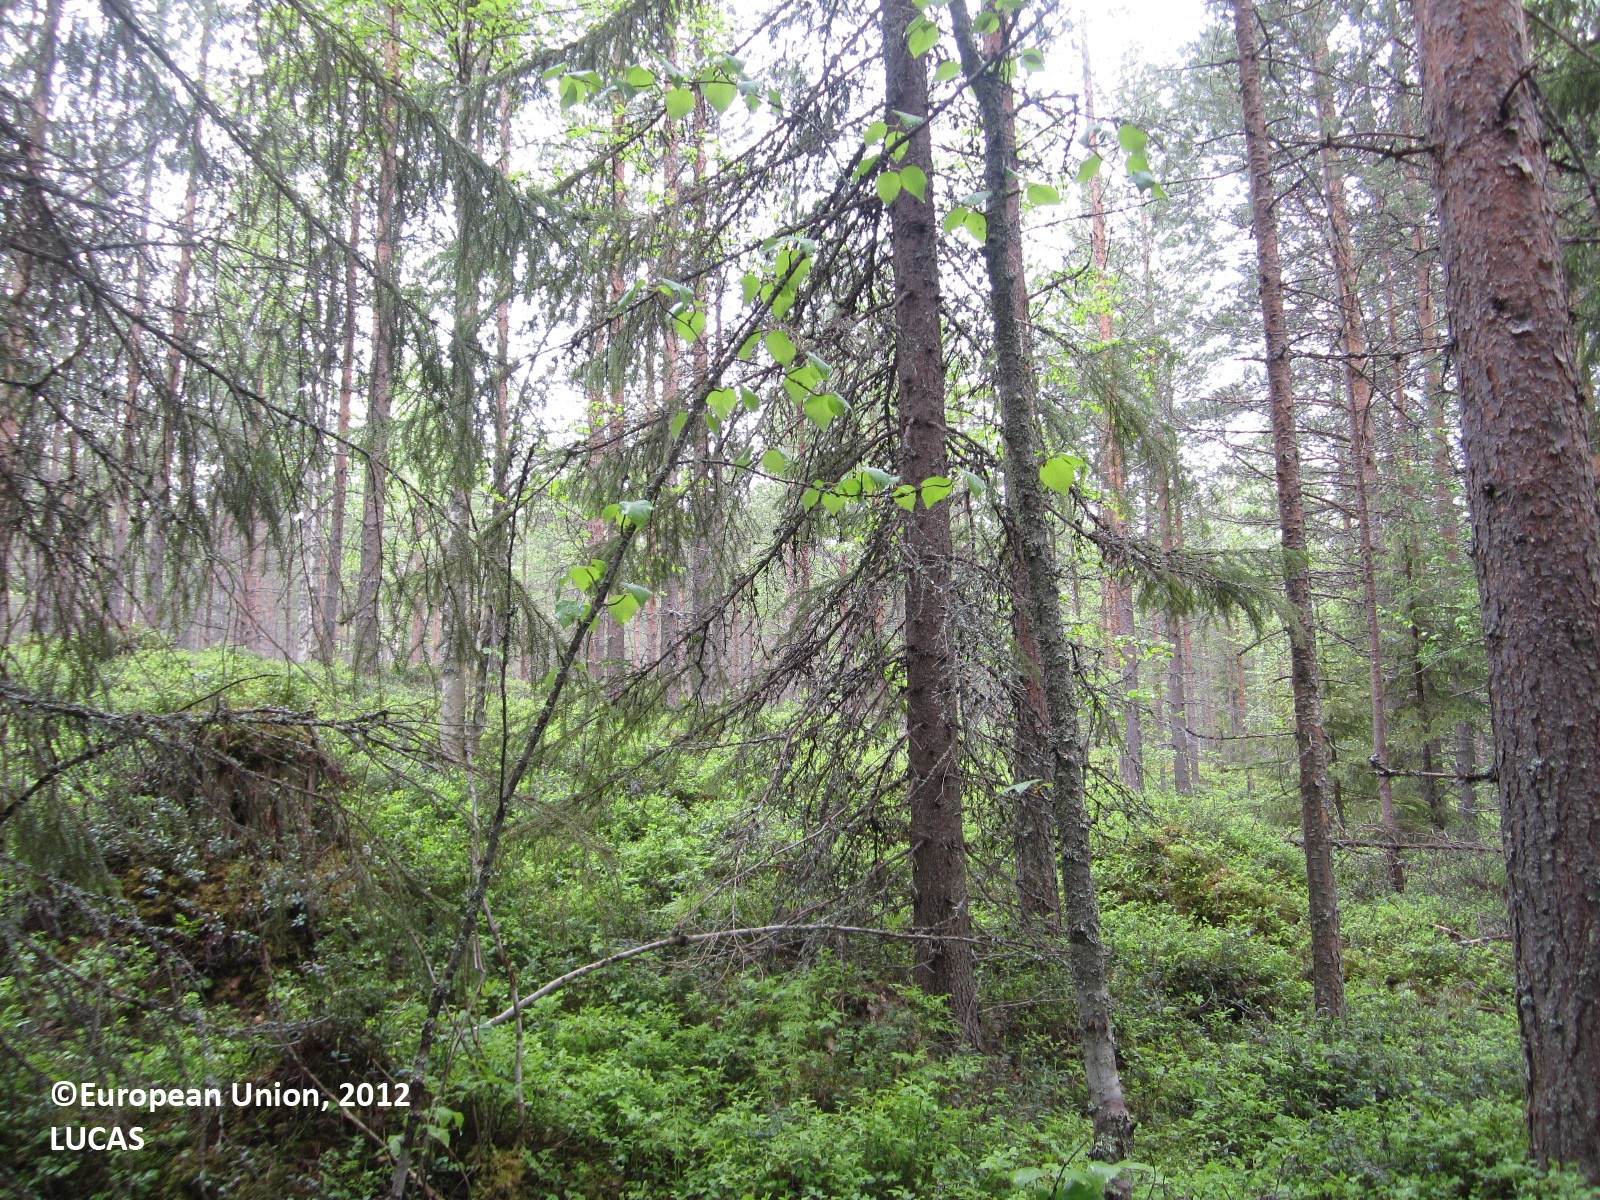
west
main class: Woodland
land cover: Pine dominated mixed woodland
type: boreal forest
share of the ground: > 75 %
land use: Forestry
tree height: > 5 m
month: June
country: FI
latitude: 64.6172
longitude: 28.6846
